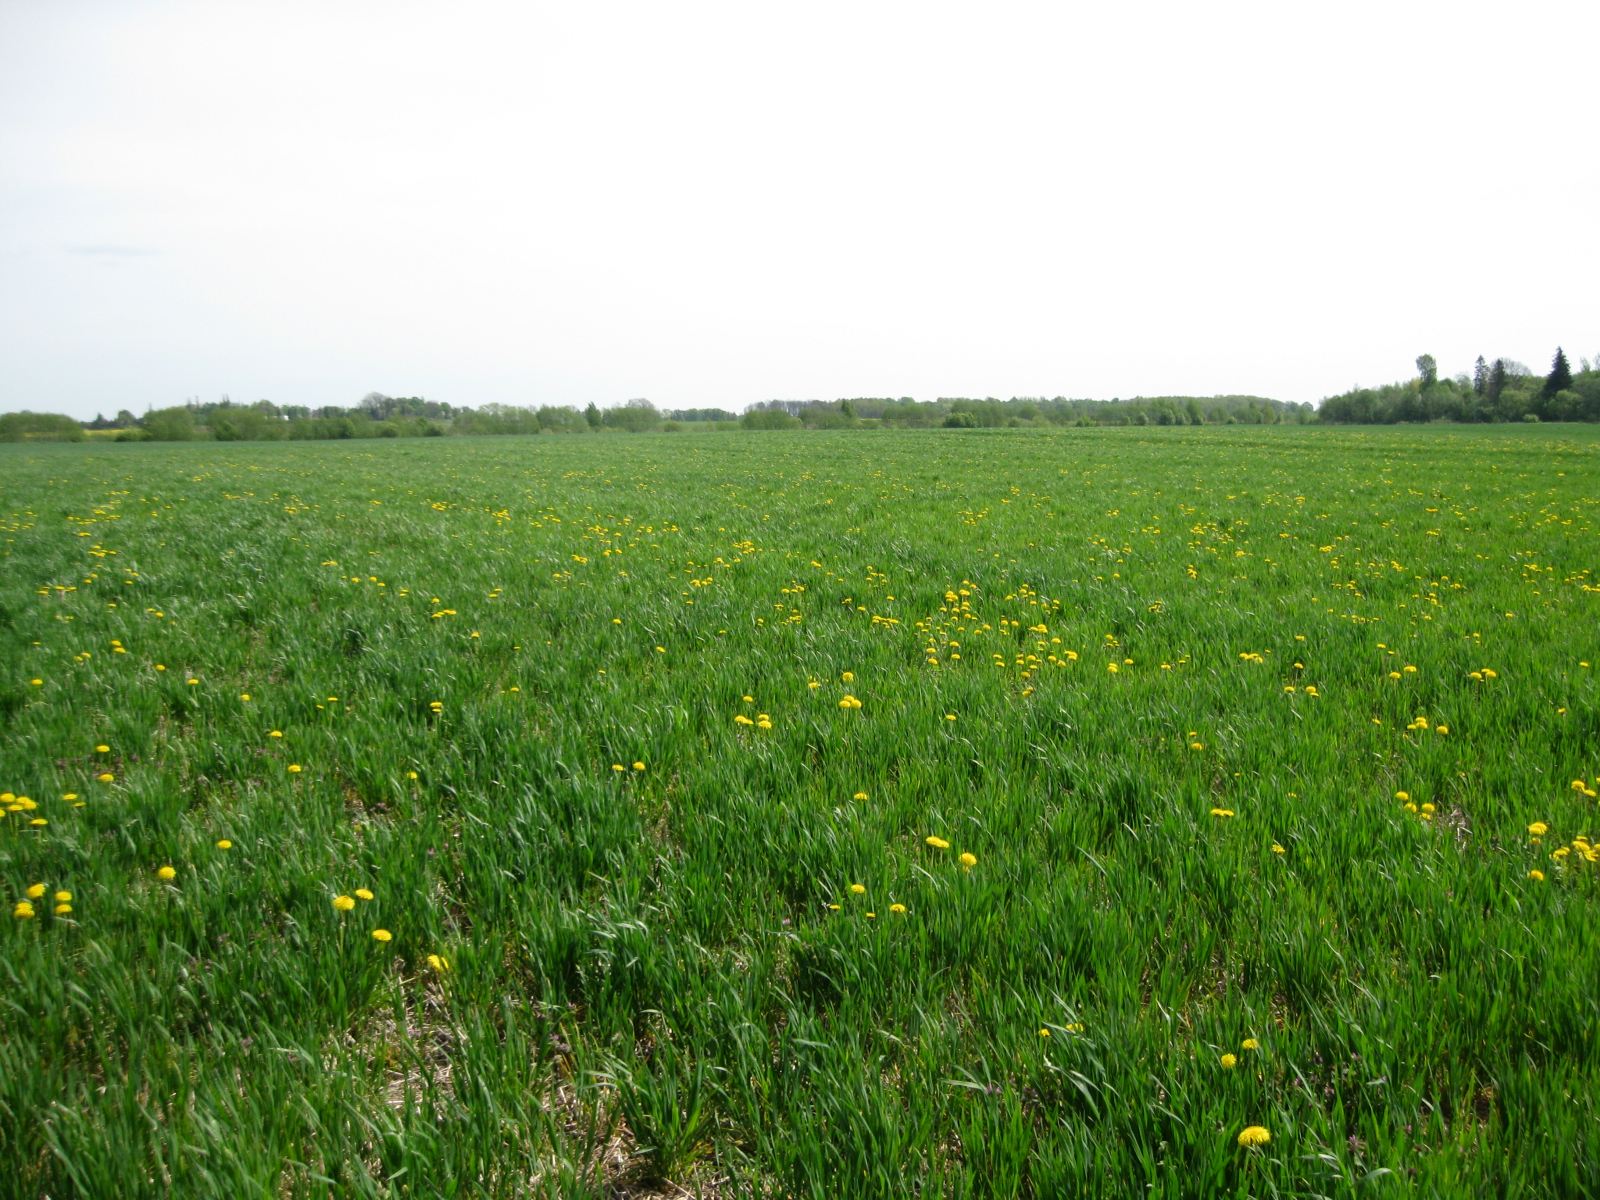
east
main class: Grassland
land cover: Grassland without tree/shrub cover
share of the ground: > 75 %
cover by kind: herbaceous plants 90 %, consolidated bare surface 10 %
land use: Agriculture (excluding fallow land and kitchen gardens)
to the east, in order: Grassland without tree/shrub cover; Common wheat
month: May
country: LT
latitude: 56.2331
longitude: 24.2063
